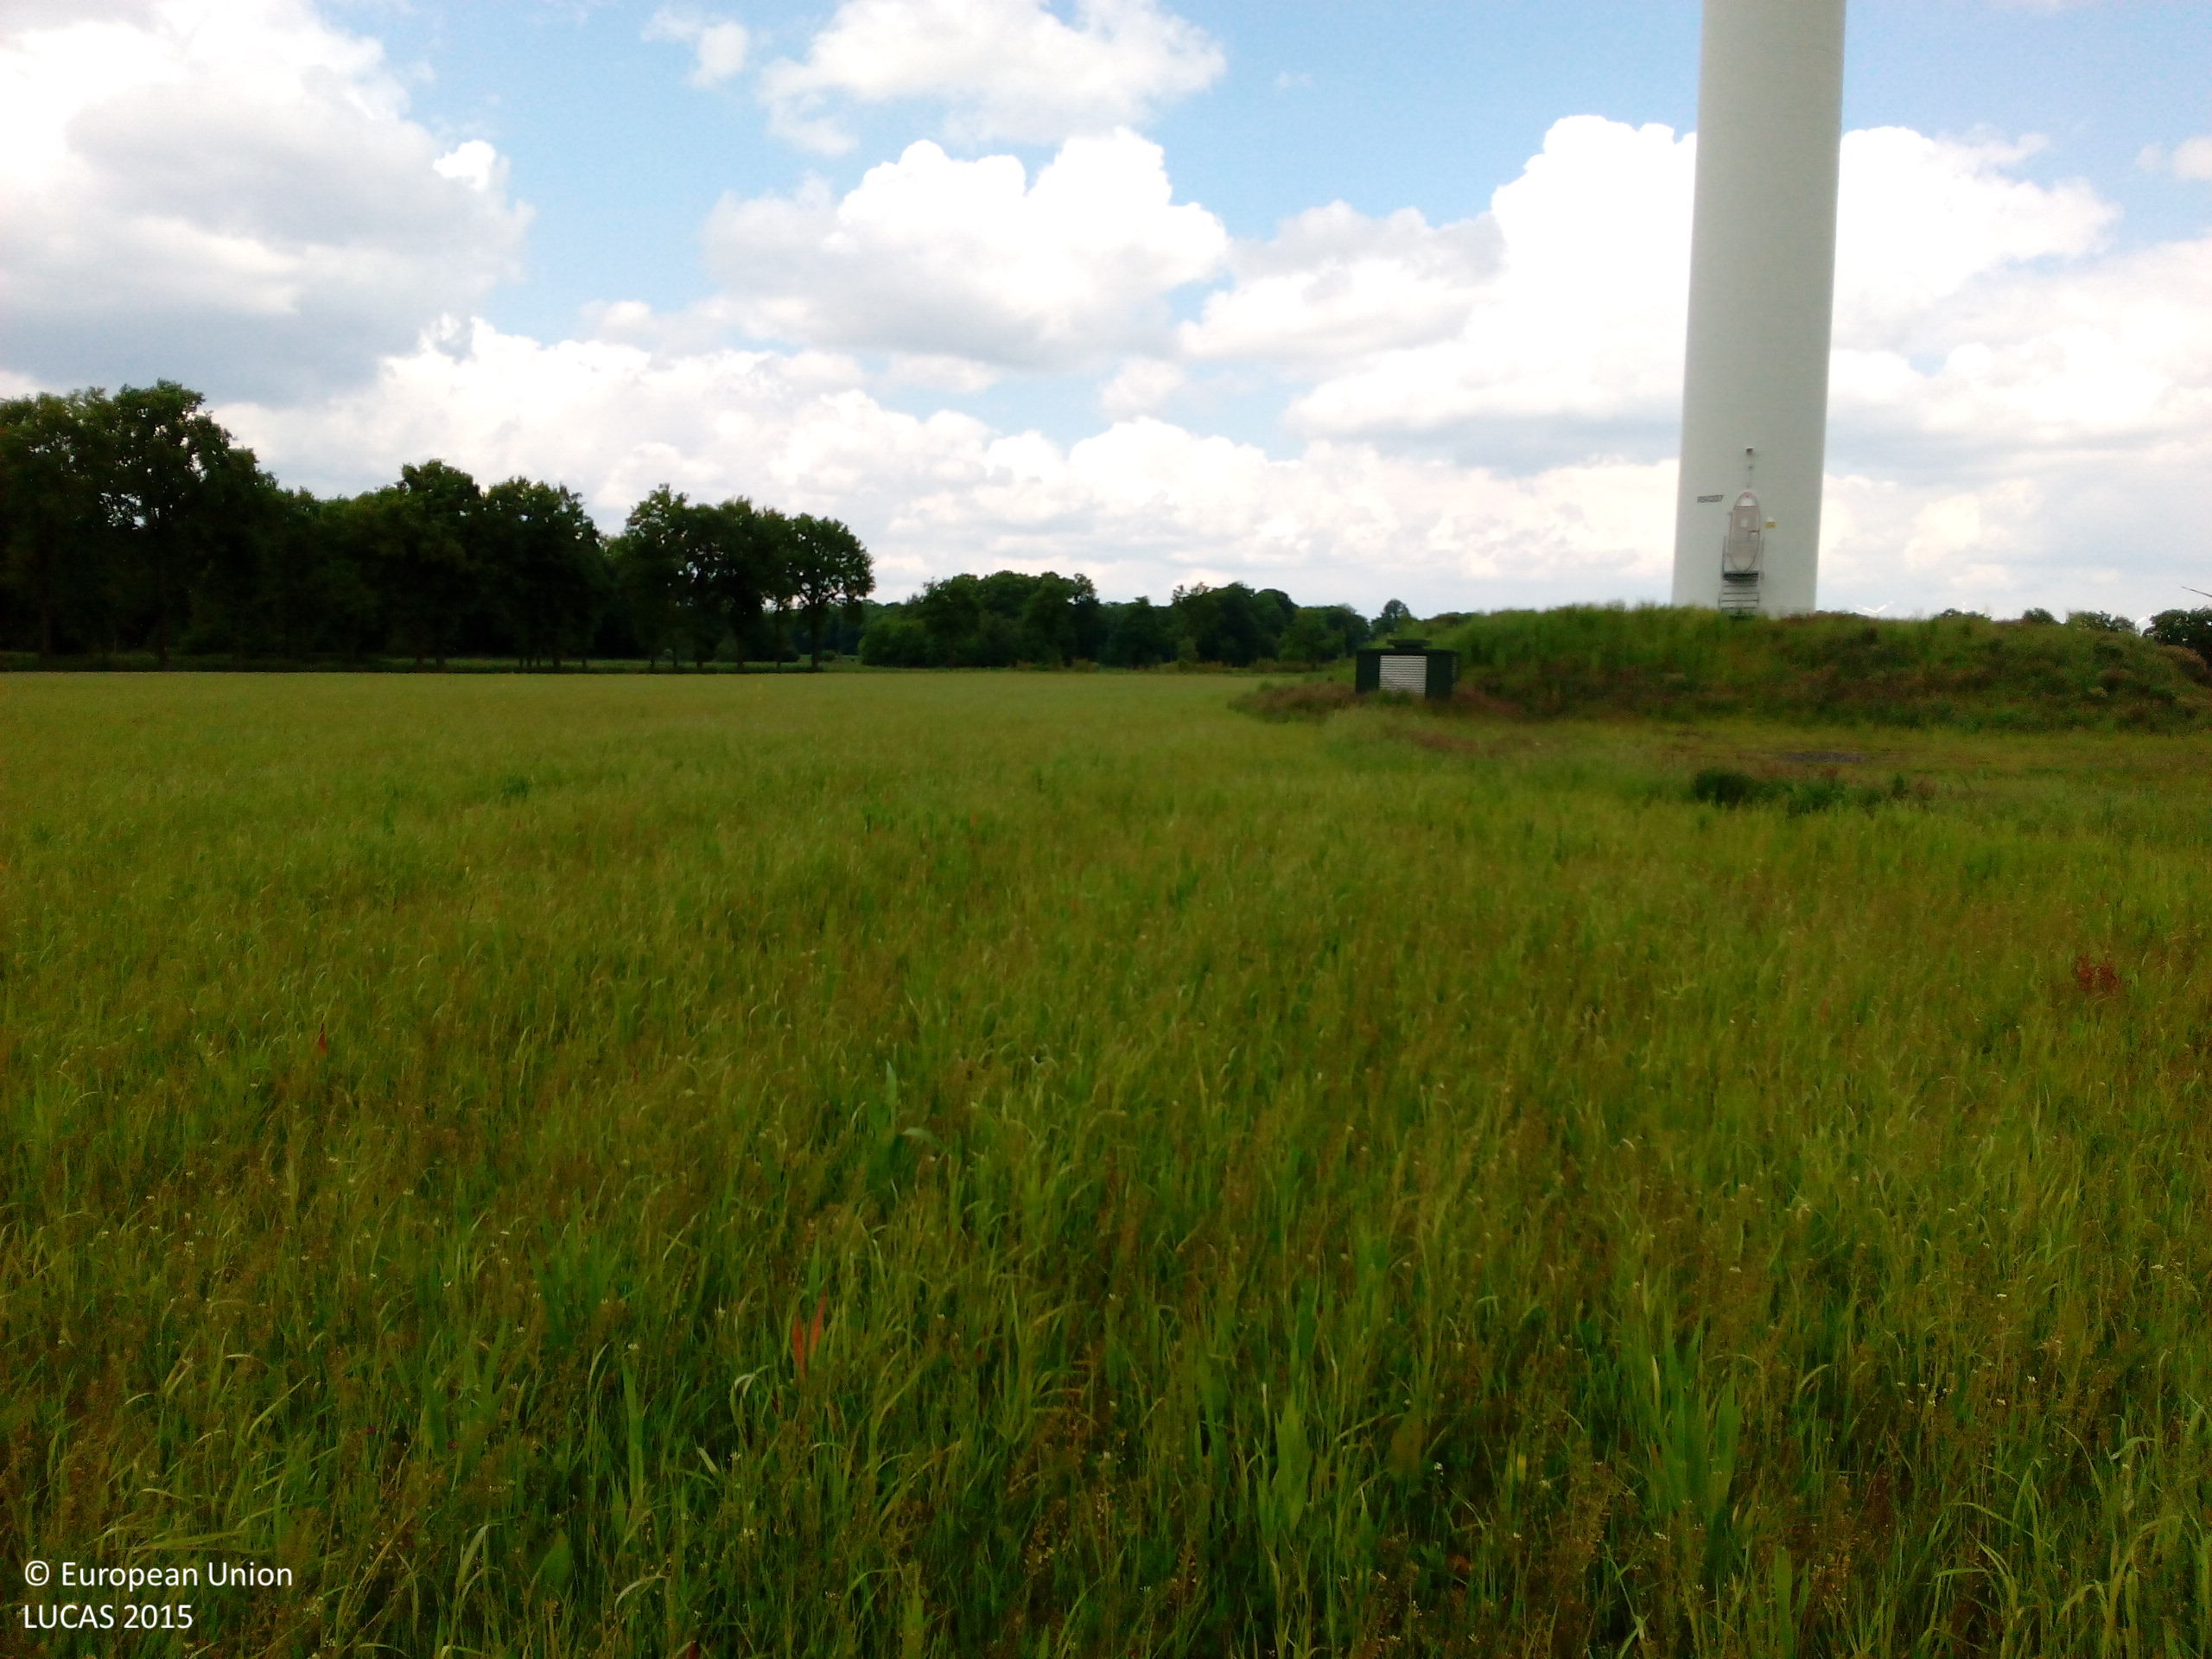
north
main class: Cropland
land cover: Mixed cereals for fodder
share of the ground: > 75 %
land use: Agriculture (excluding fallow land and kitchen gardens)
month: May
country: DE
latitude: 52.1868
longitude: 7.3821
